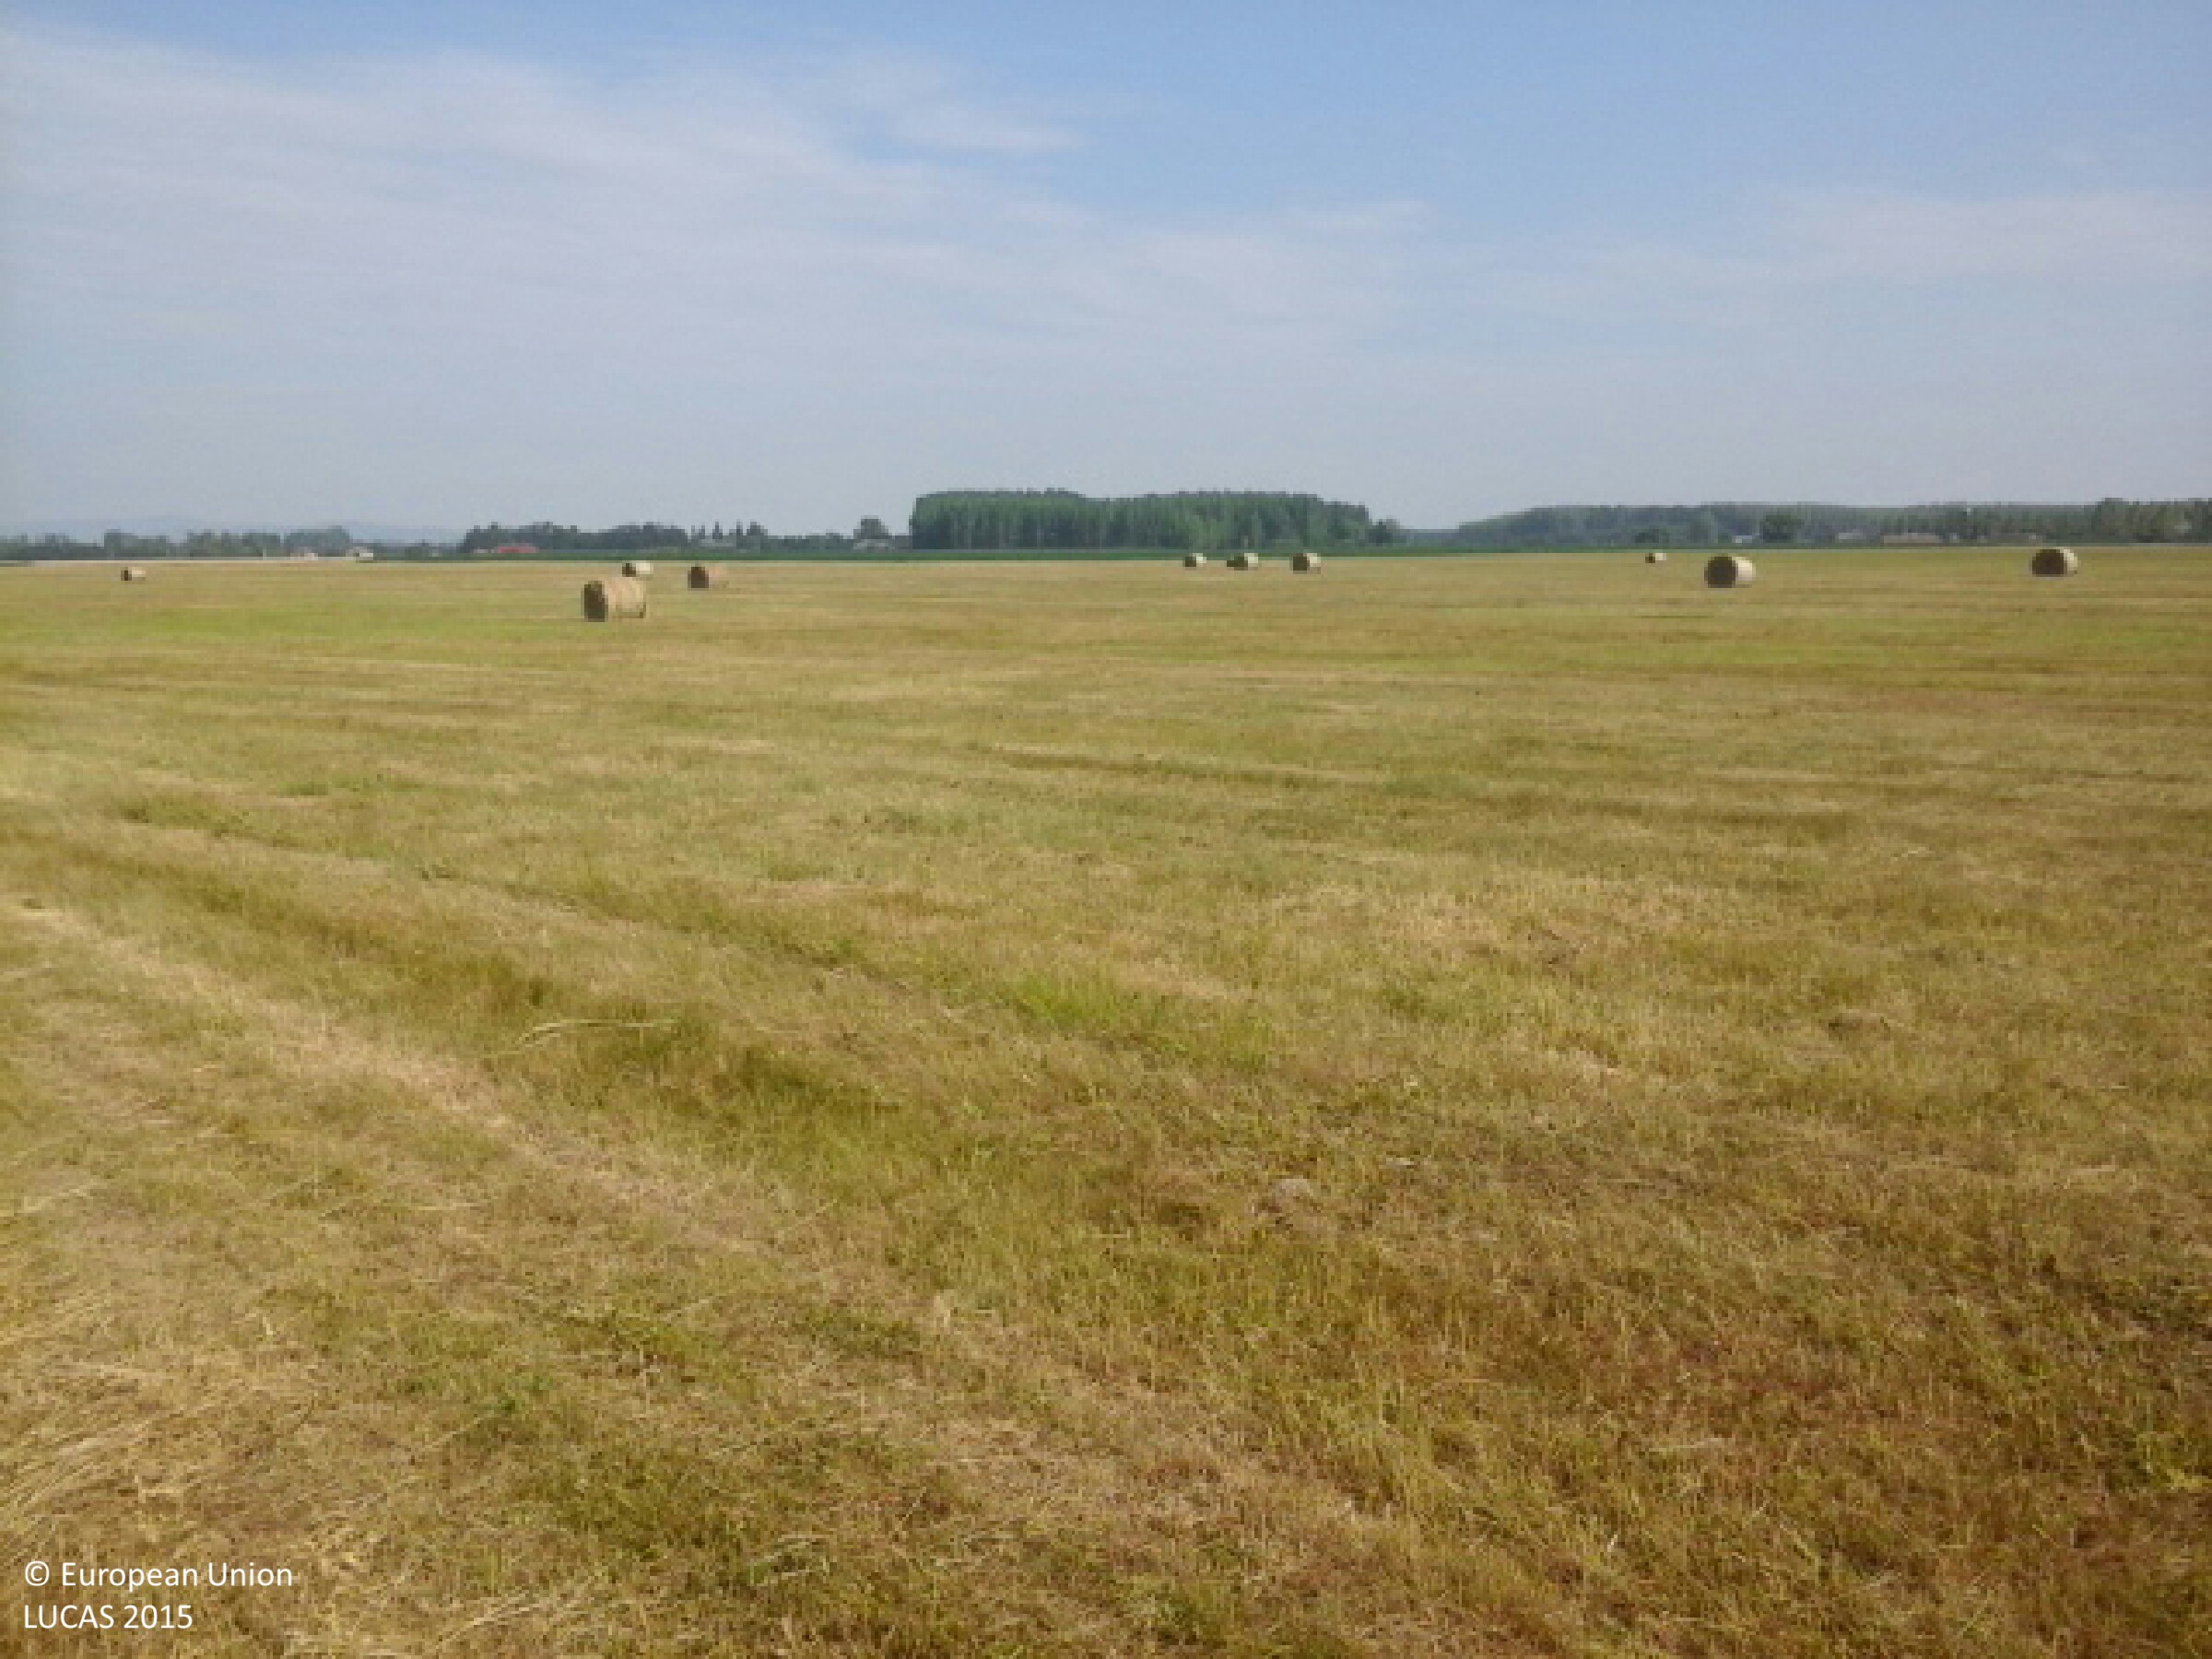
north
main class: Grassland
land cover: Grassland without tree/shrub cover
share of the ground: > 75 %
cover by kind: herbaceous plants 100 %
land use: Agriculture (excluding fallow land and kitchen gardens)
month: June
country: HU
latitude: 48.3270
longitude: 21.8532
